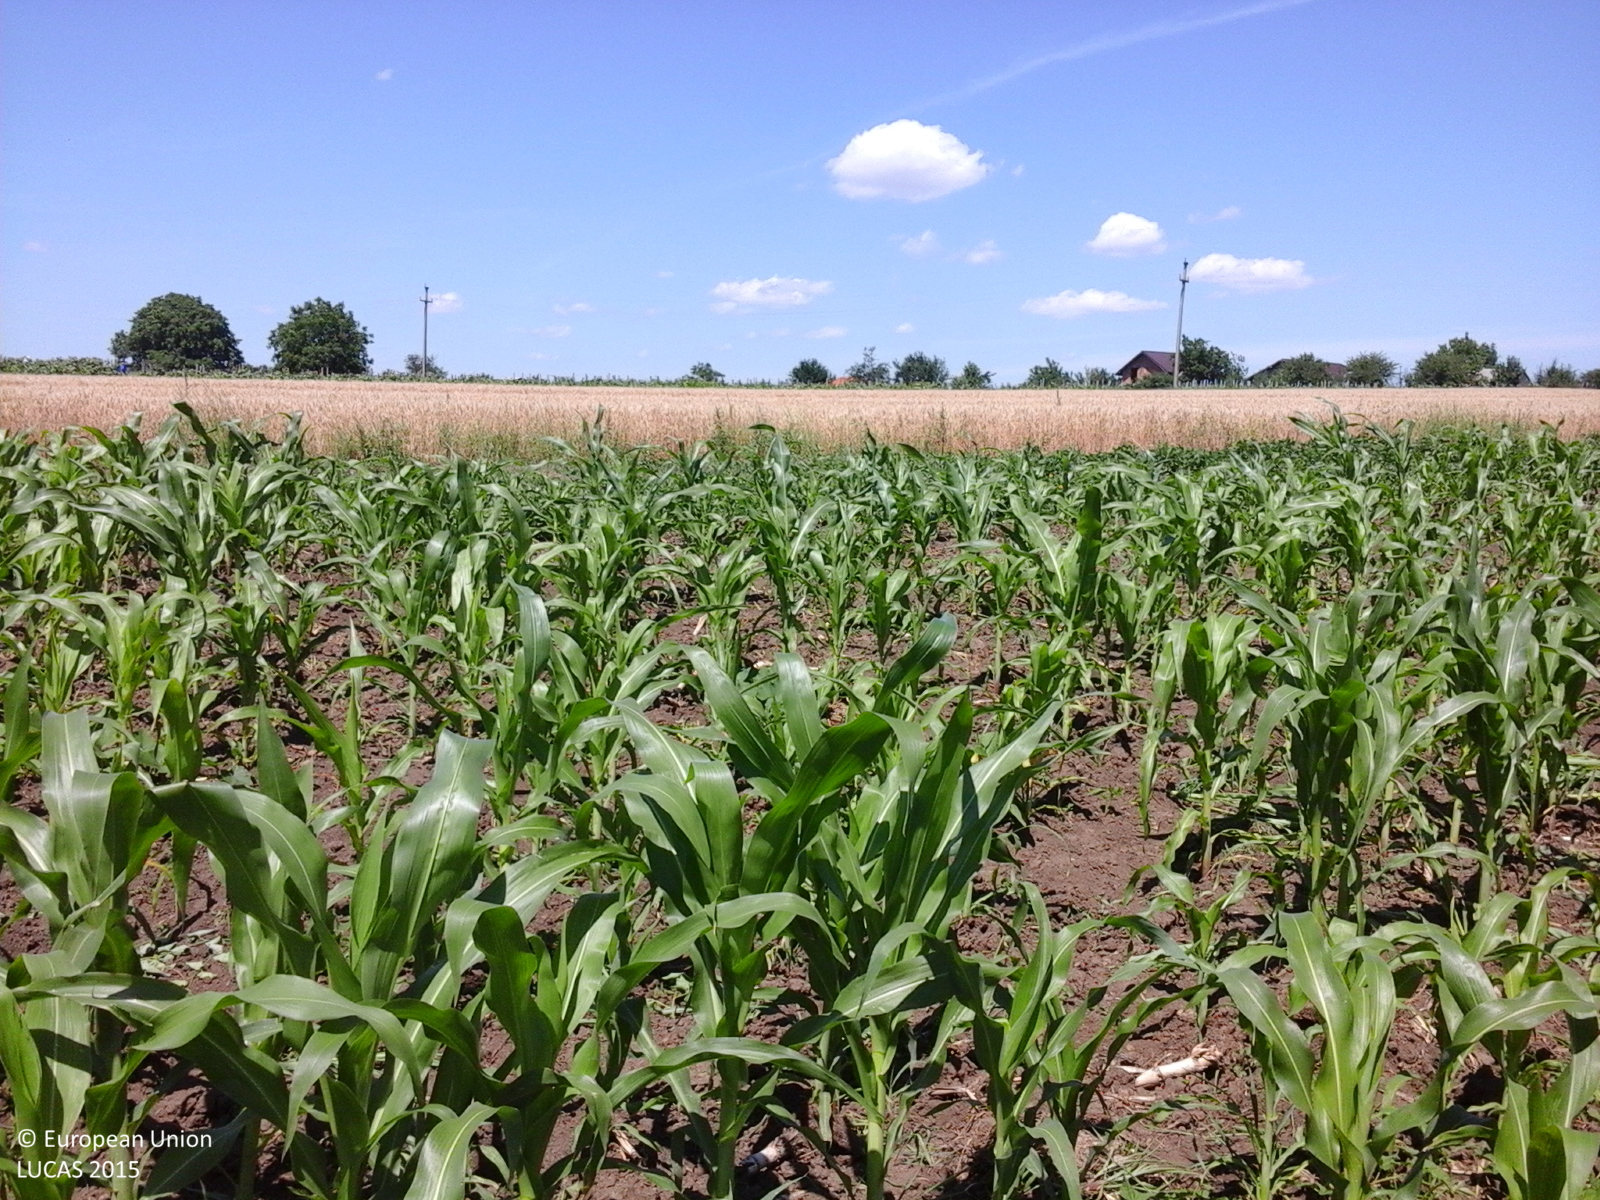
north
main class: Cropland
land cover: Maize
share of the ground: > 75 %
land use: Agriculture (excluding fallow land and kitchen gardens)
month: June
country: RO
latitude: 47.1885
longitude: 27.0888
